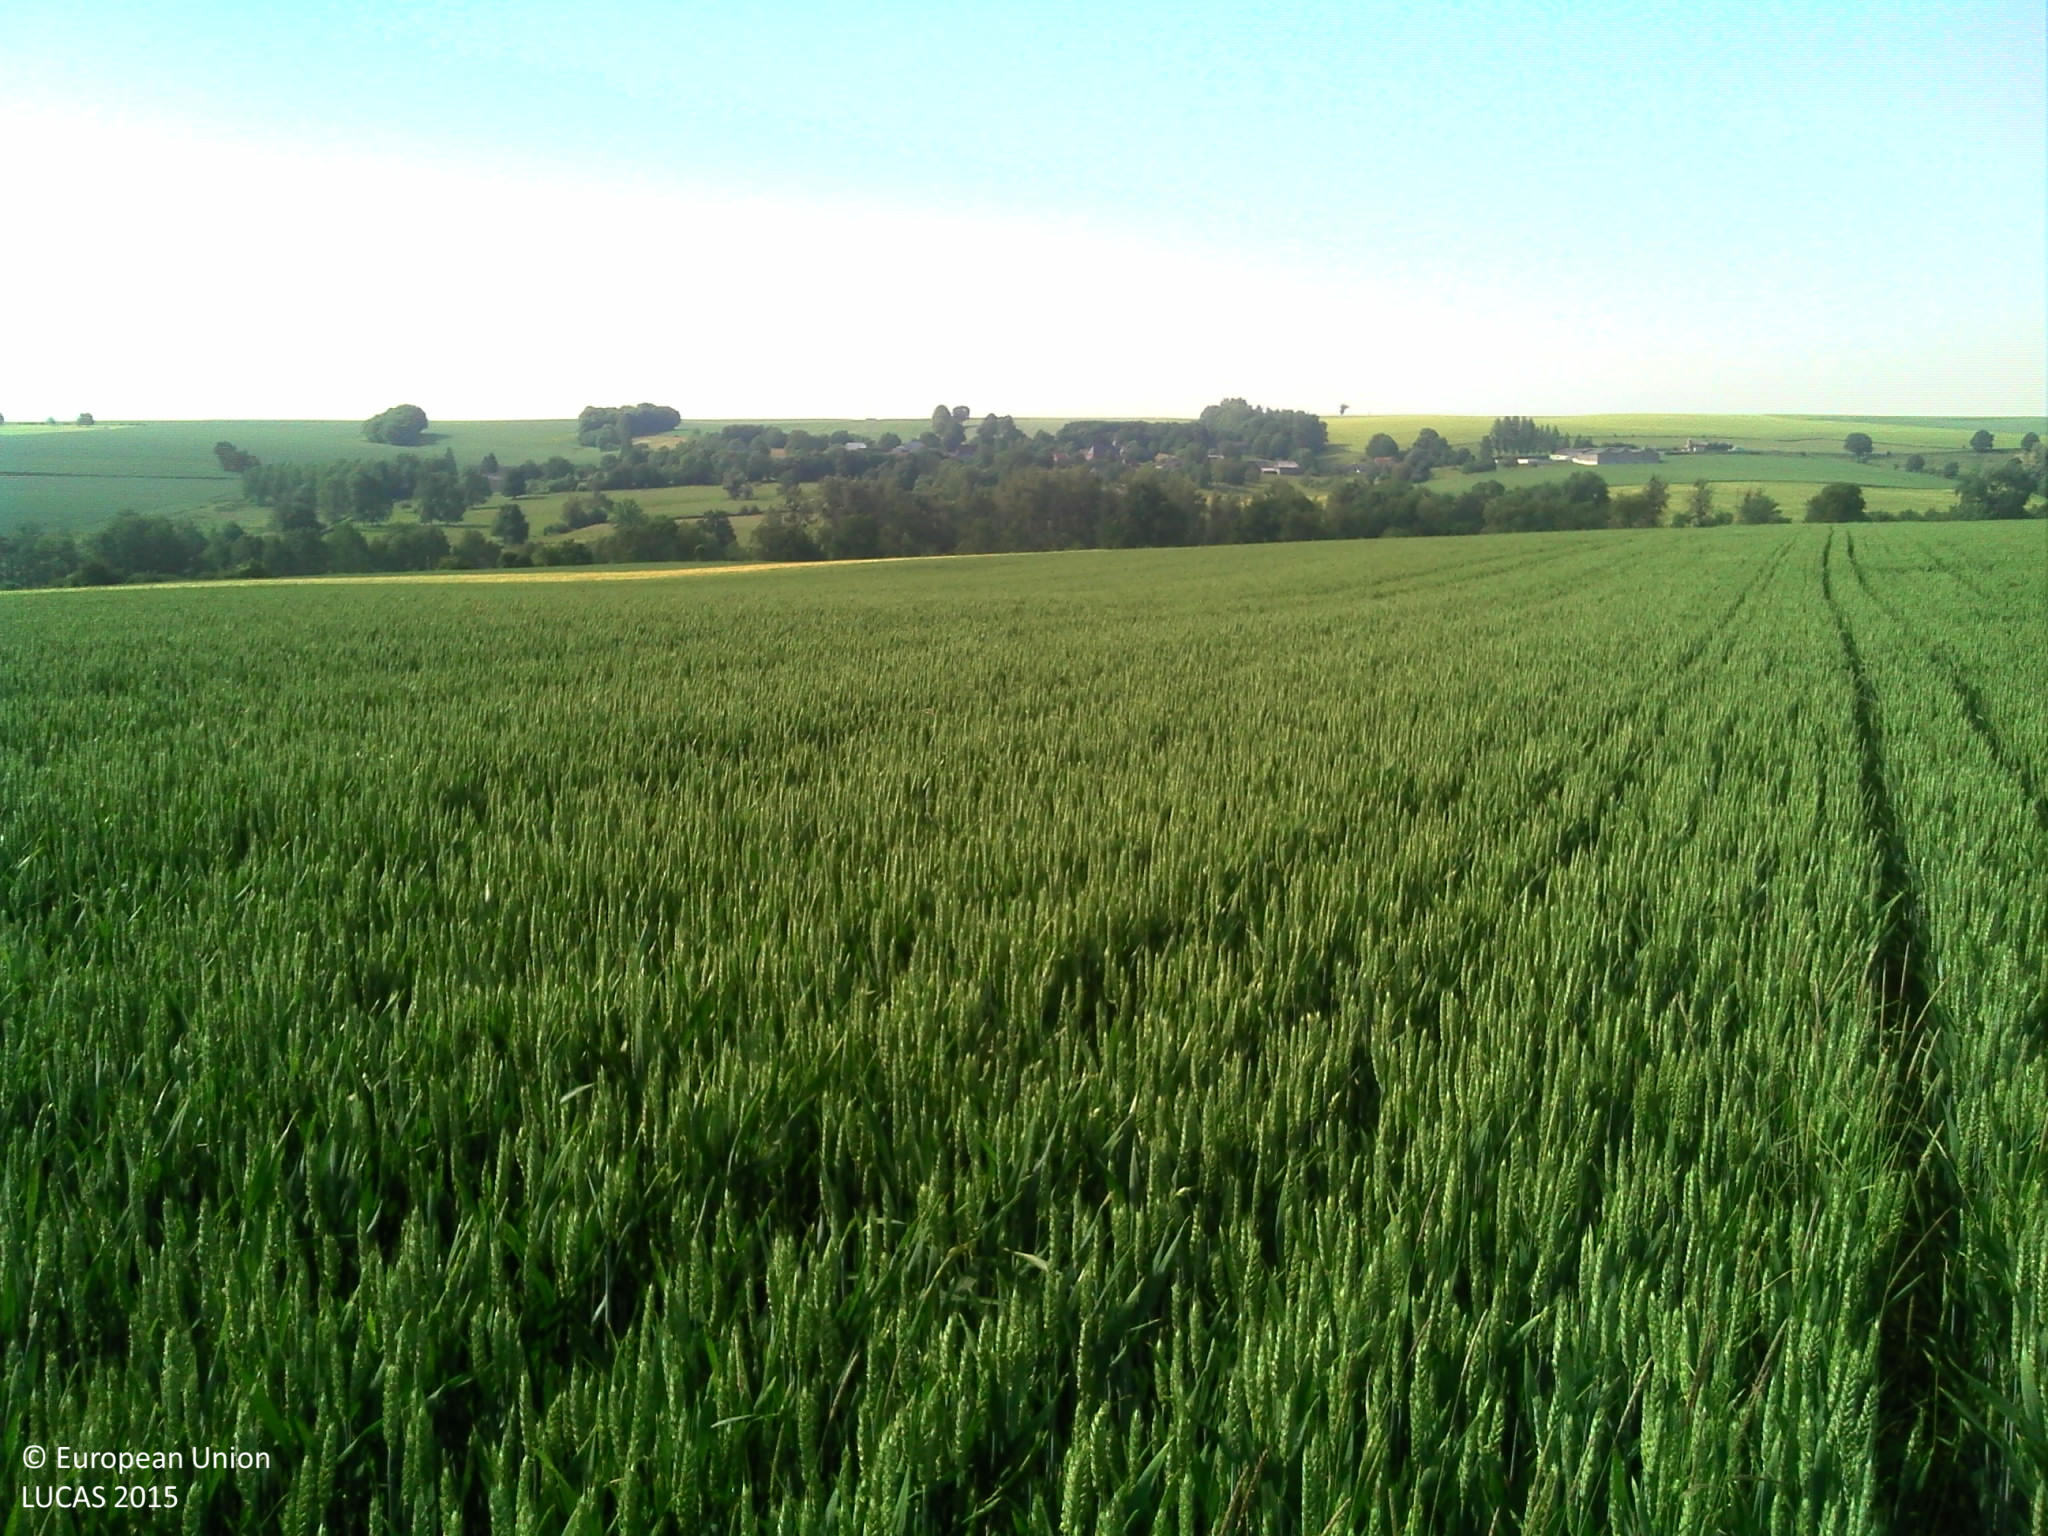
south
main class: Cropland
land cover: Common wheat
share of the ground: > 75 %
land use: Agriculture (excluding fallow land and kitchen gardens)
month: June
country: FR
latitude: 49.8116
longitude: 4.0329
